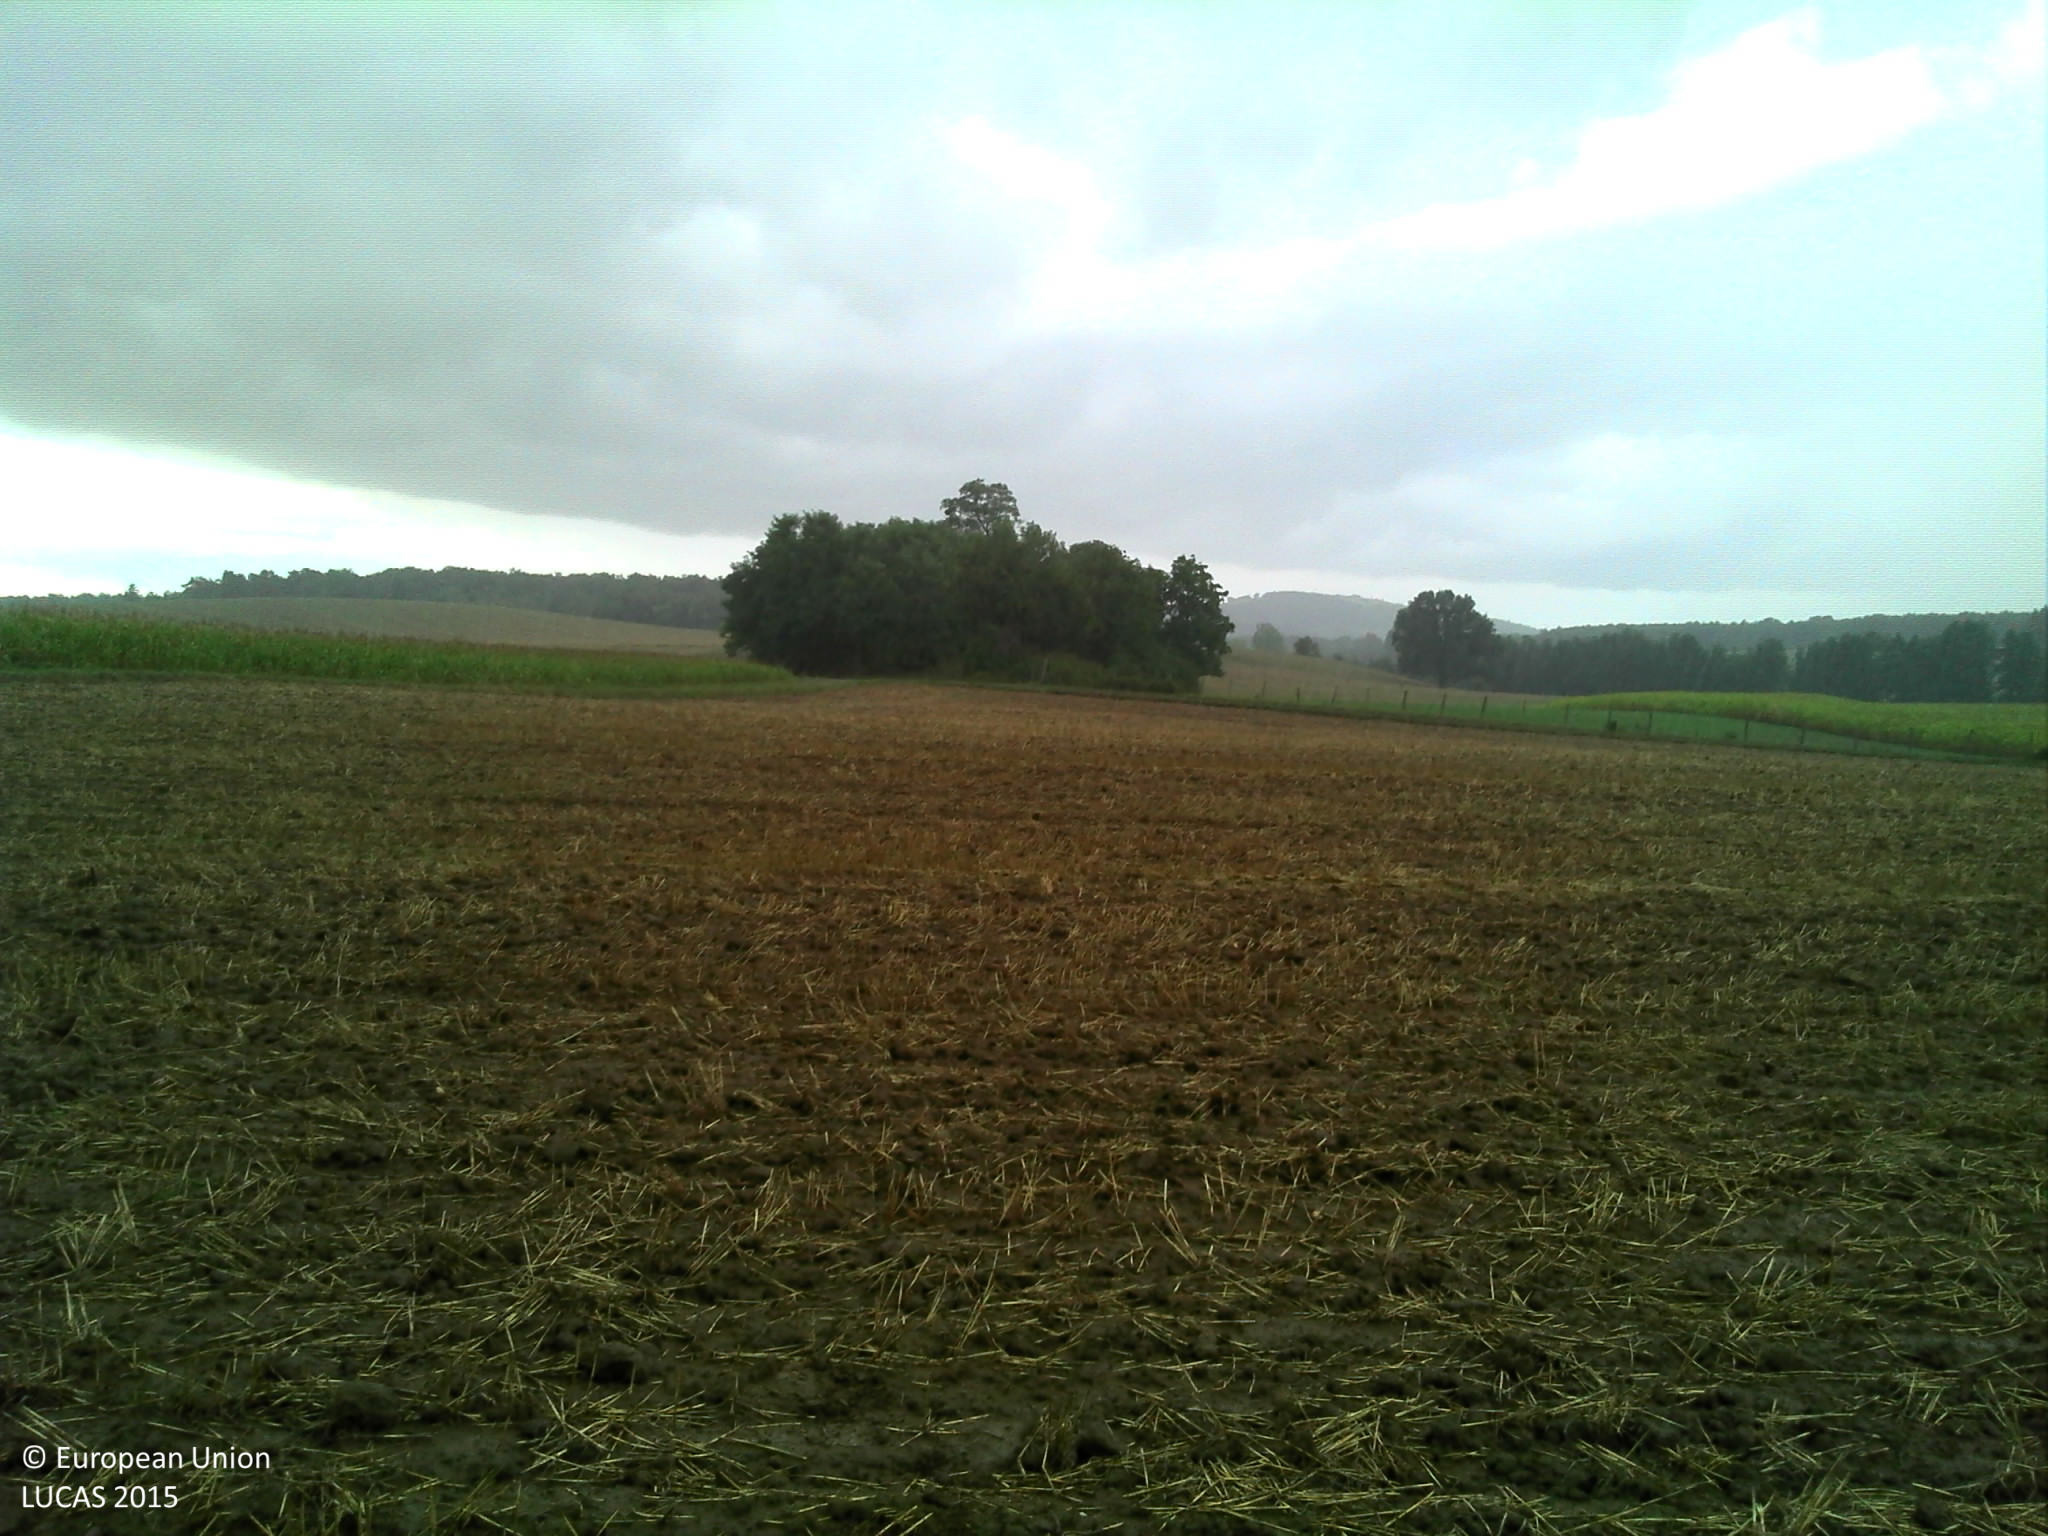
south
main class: Cropland
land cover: Triticale
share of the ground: 10 - 25 %
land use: Agriculture (excluding fallow land and kitchen gardens)
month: August
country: FR
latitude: 48.8422
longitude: 7.4526
